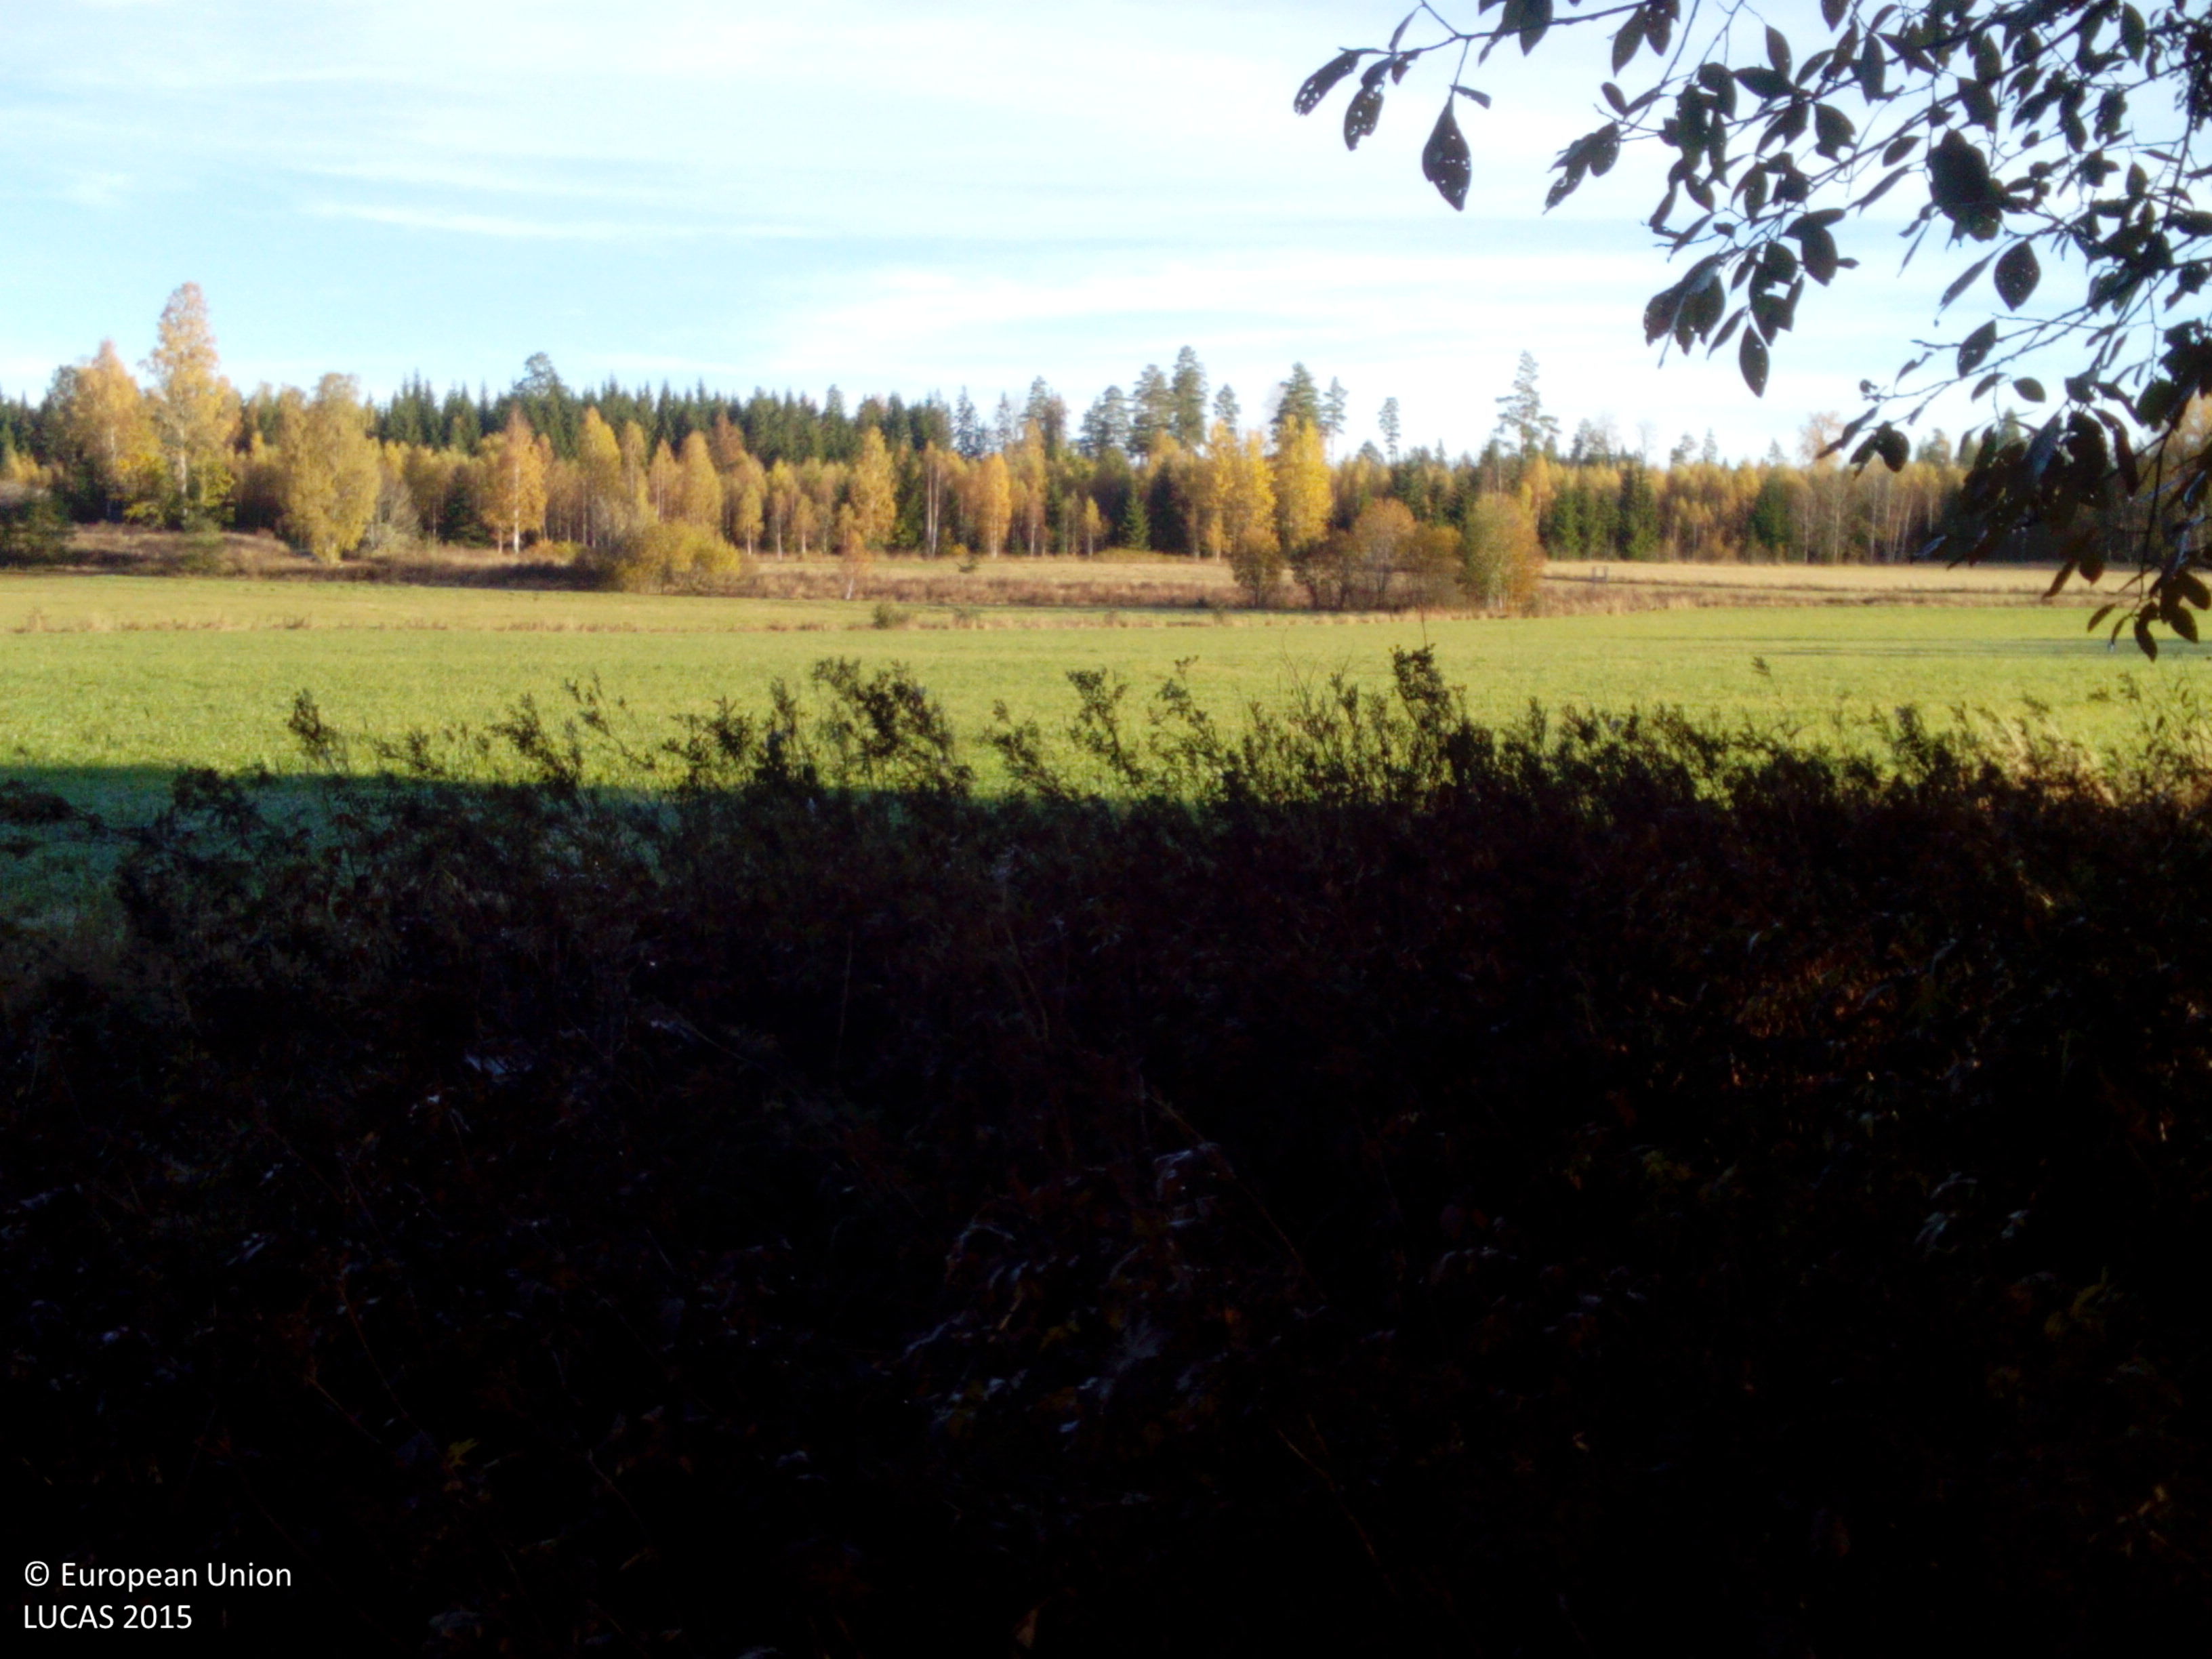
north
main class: Woodland
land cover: Broadleaved woodland
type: hemiboreal forest and nemoral coniferous forest and mixed broadleaved-coniferous forest
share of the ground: 25 - 50 %
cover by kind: herbaceous plants 60 %, broadleaved forest trees 40 %
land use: Semi-natural and natural areas not in use
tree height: > 5 m
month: October
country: SE
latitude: 59.1173
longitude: 16.3341
